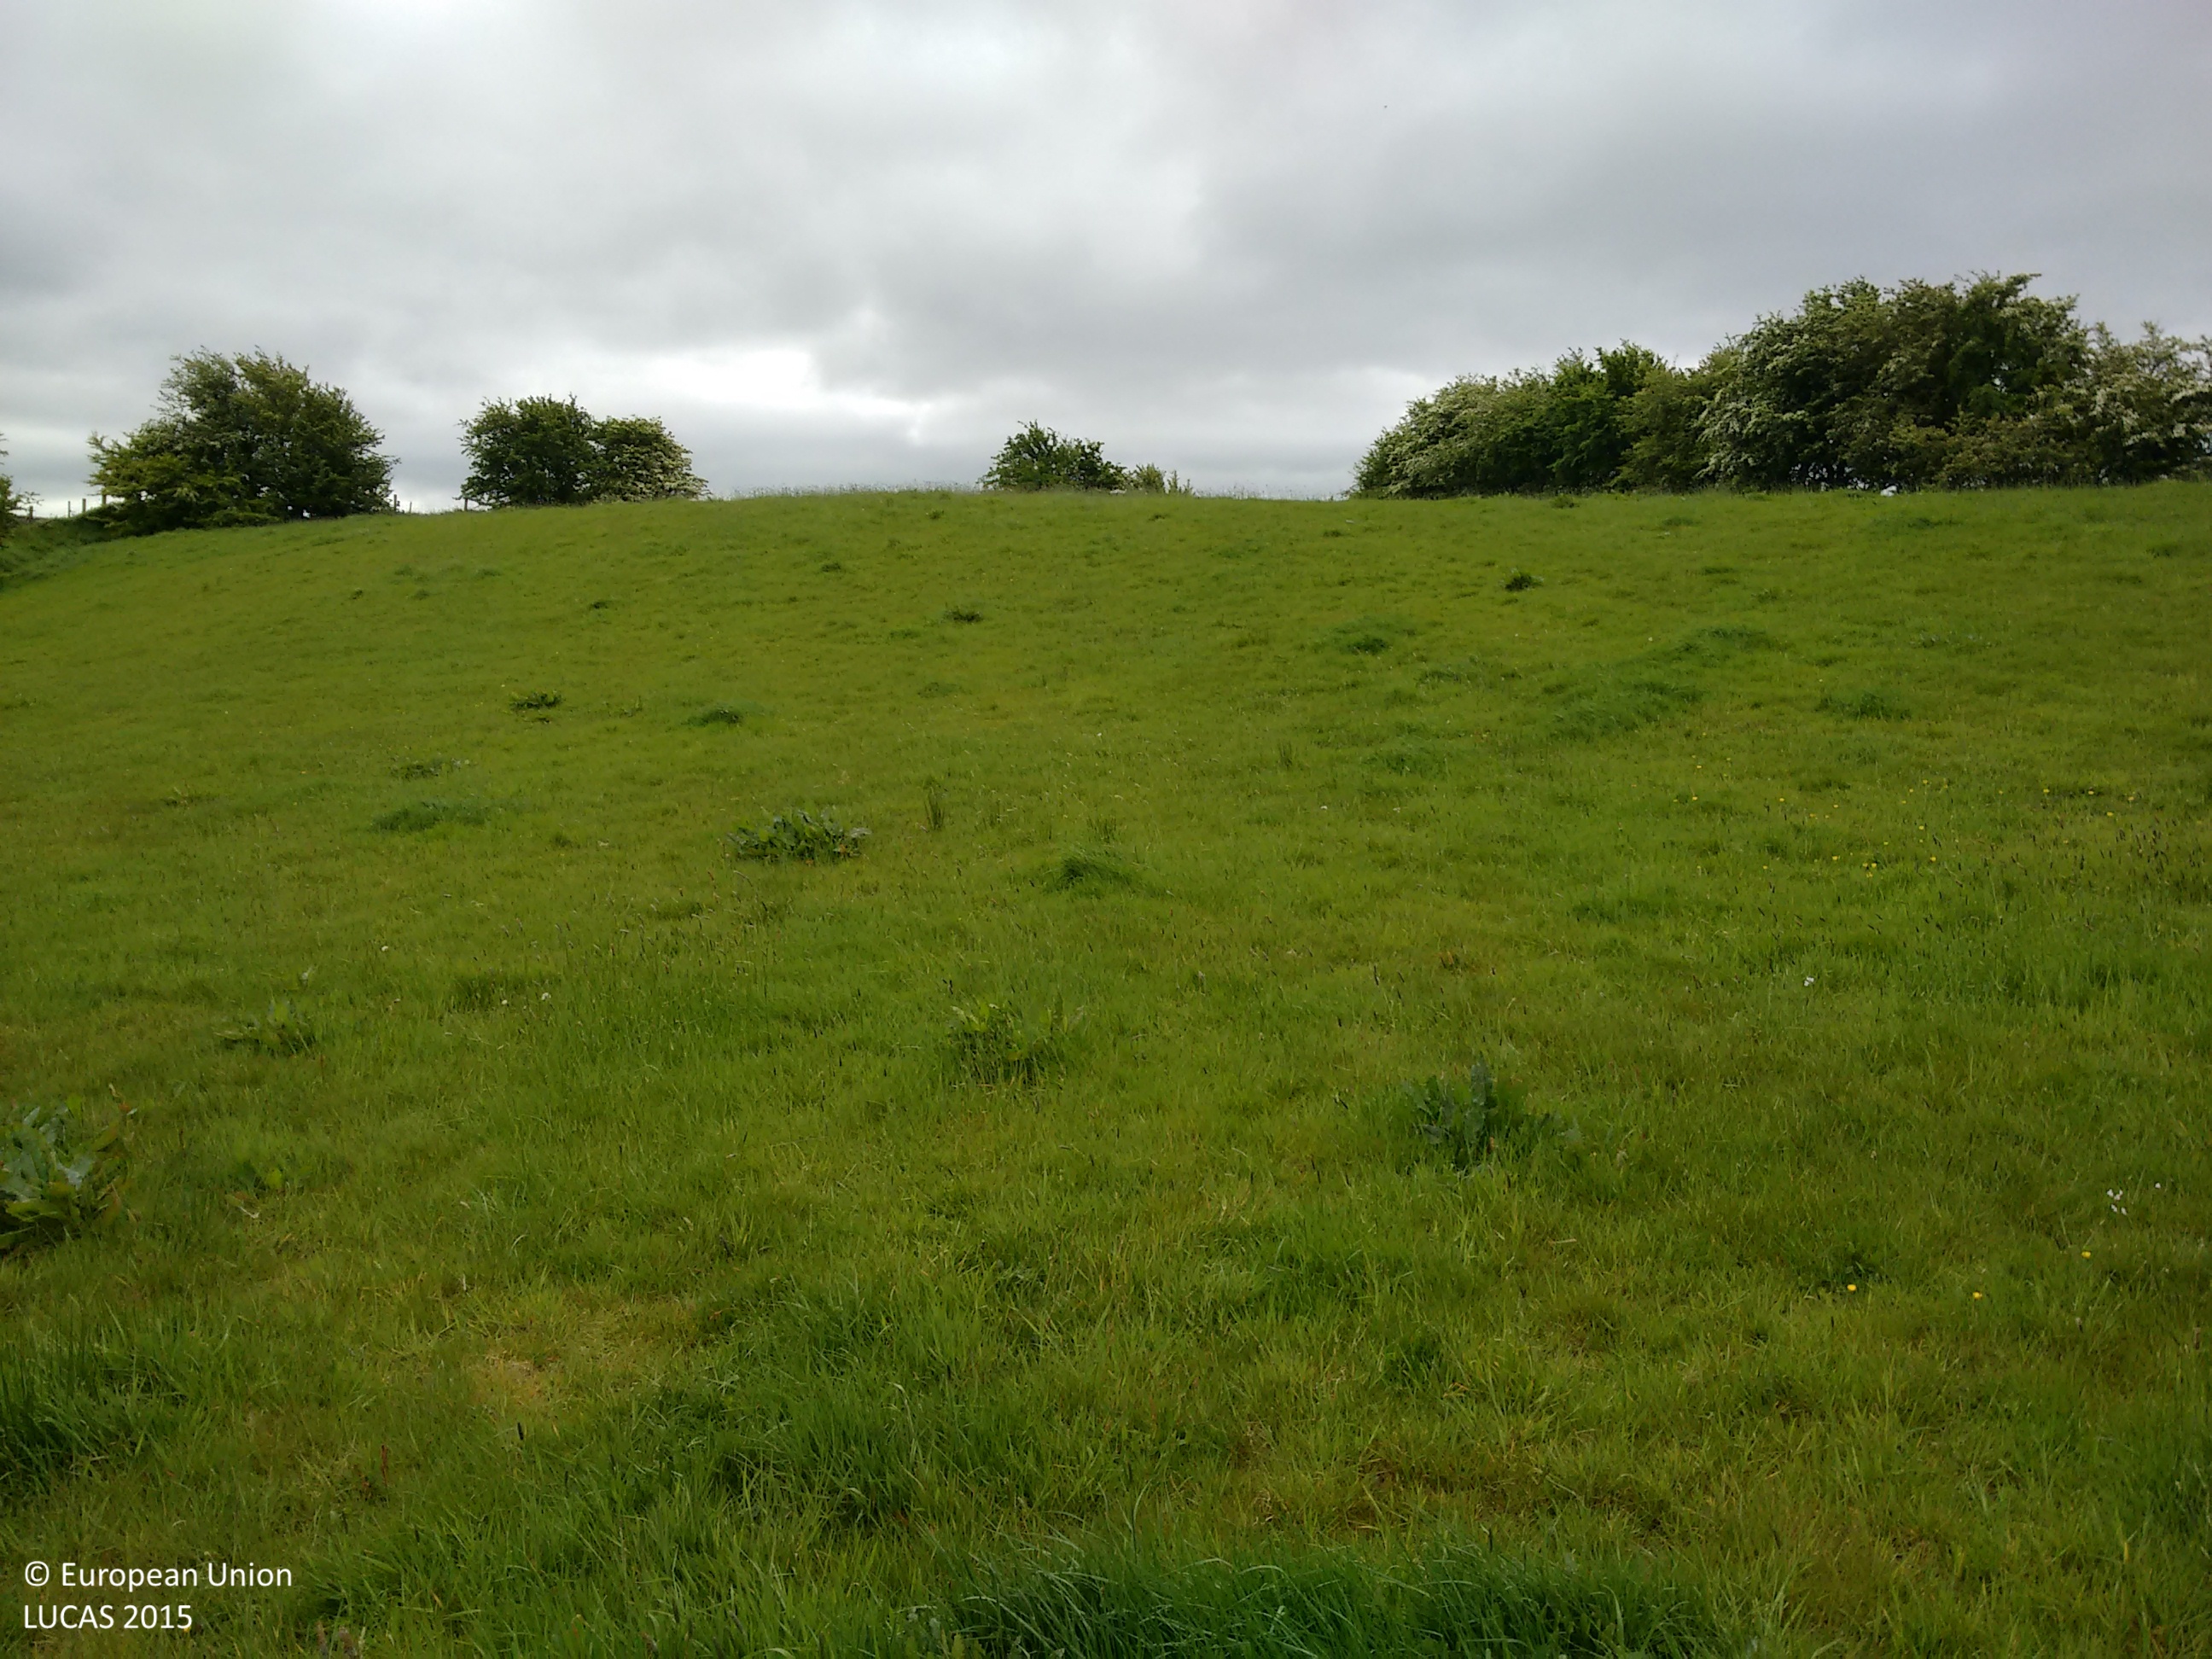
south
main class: Grassland
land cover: Grassland without tree/shrub cover
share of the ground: > 75 %
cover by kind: herbaceous plants 100 %
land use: Agriculture (excluding fallow land and kitchen gardens)
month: May
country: IE
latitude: 53.3468
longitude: -8.5982
